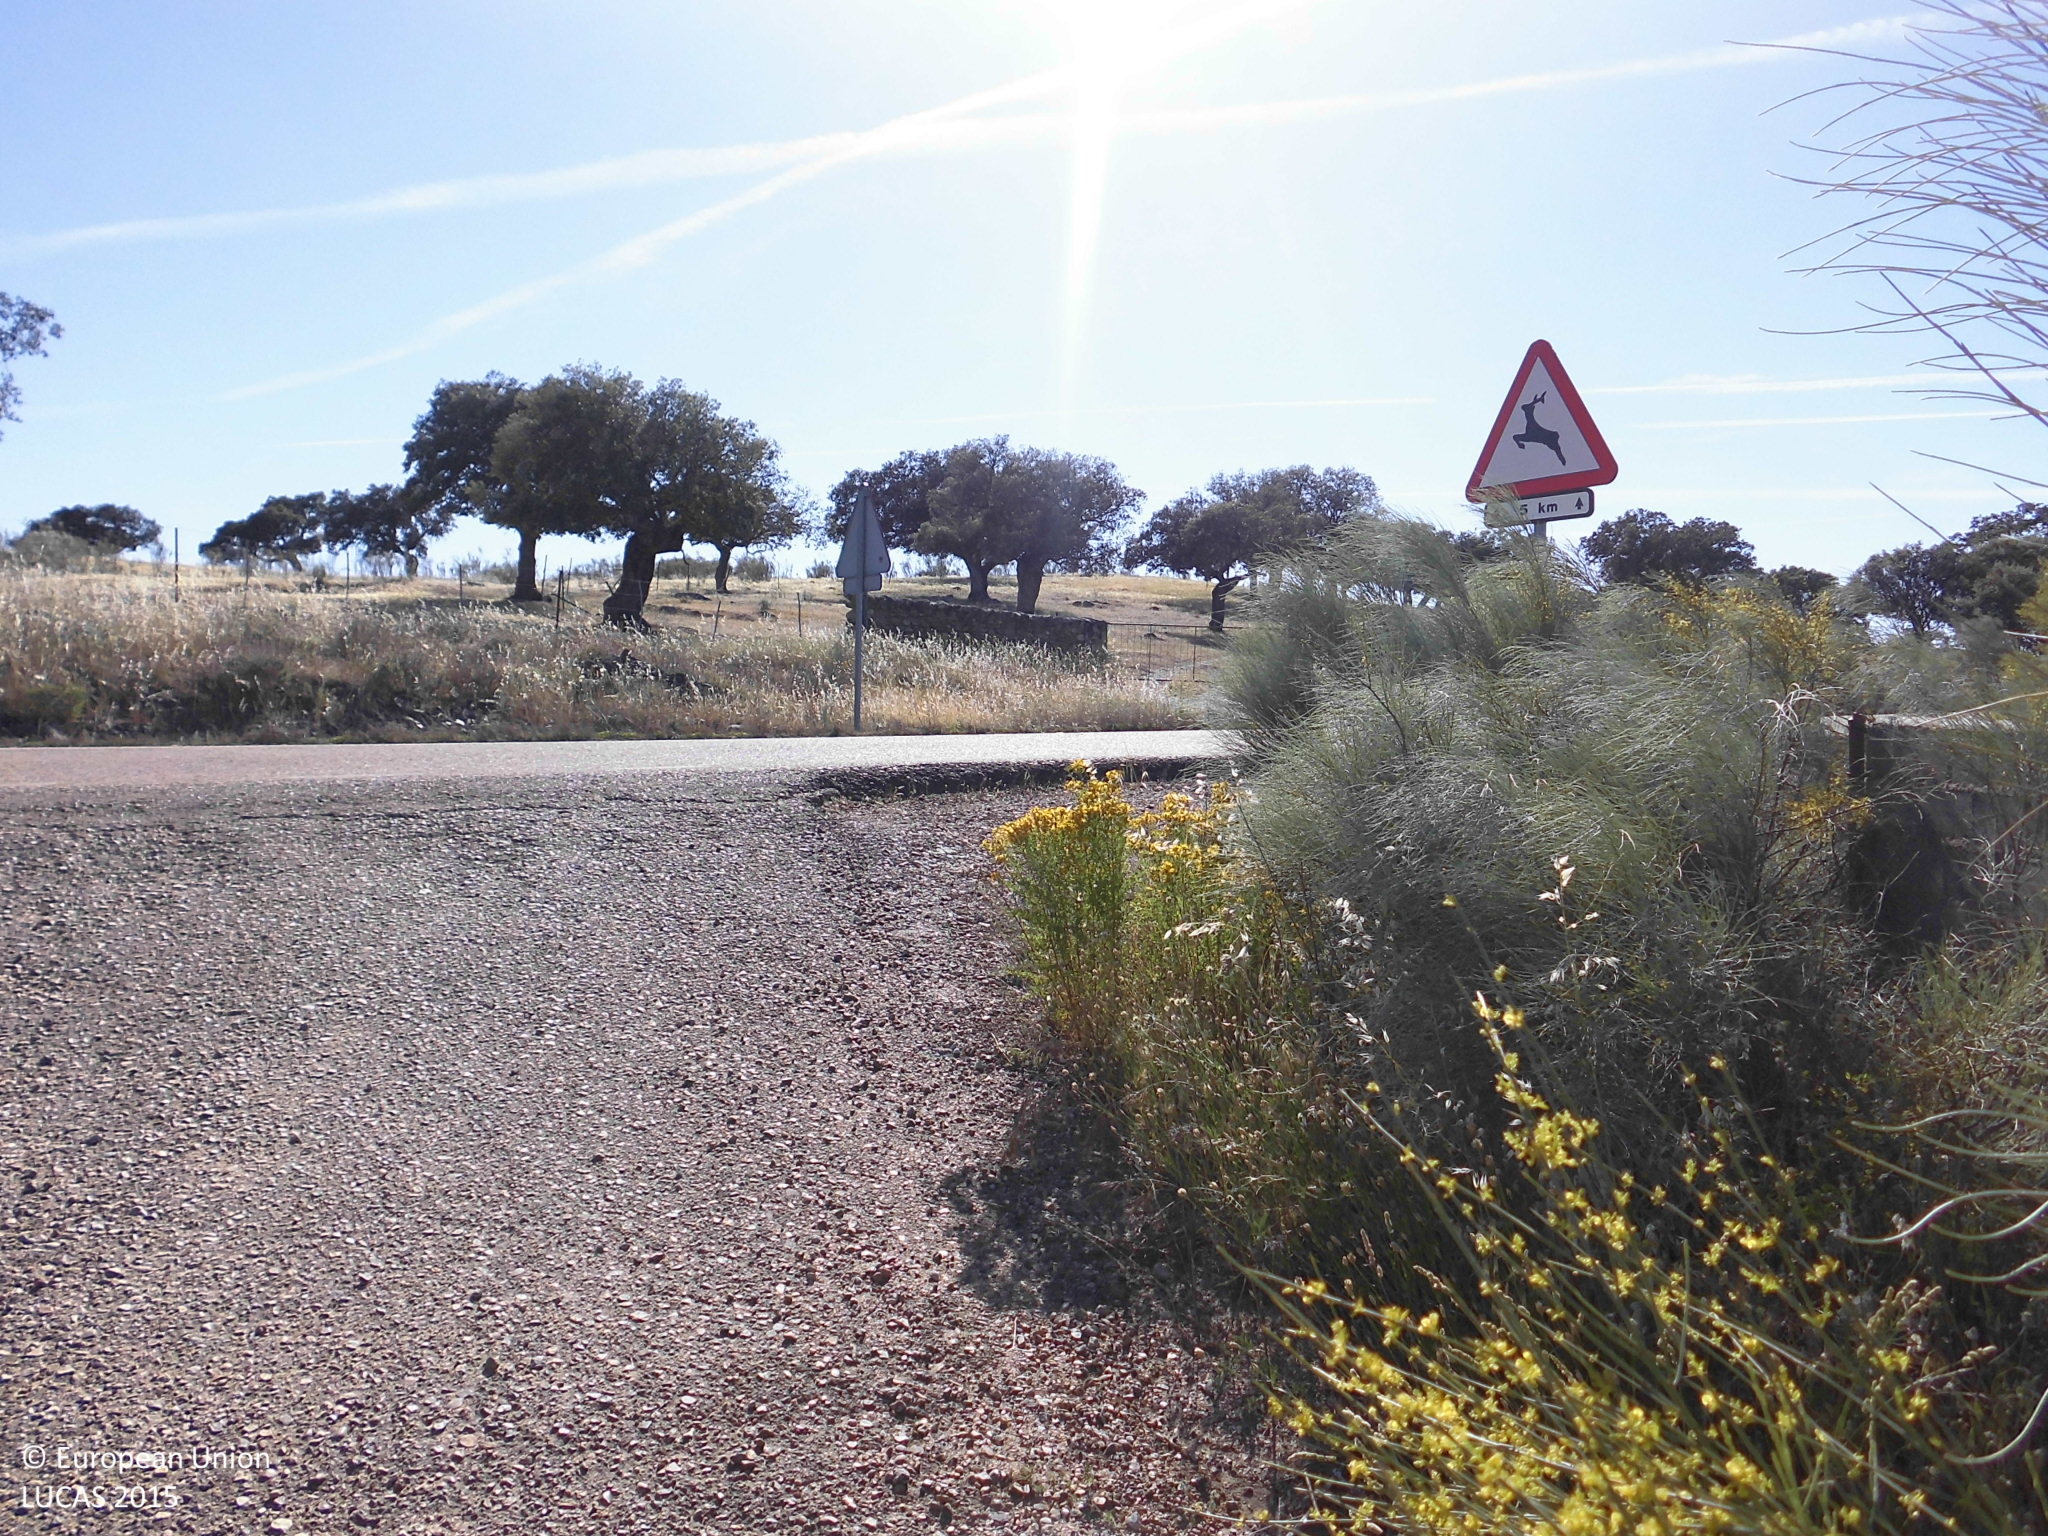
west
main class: Shrubland
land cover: Shrubland without tree cover
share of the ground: 10 - 25 %
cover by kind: herbaceous plants 80 %, shrubs 20 %
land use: Agriculture (excluding fallow land and kitchen gardens)
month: May
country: ES
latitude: 39.4796
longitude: -6.8538
